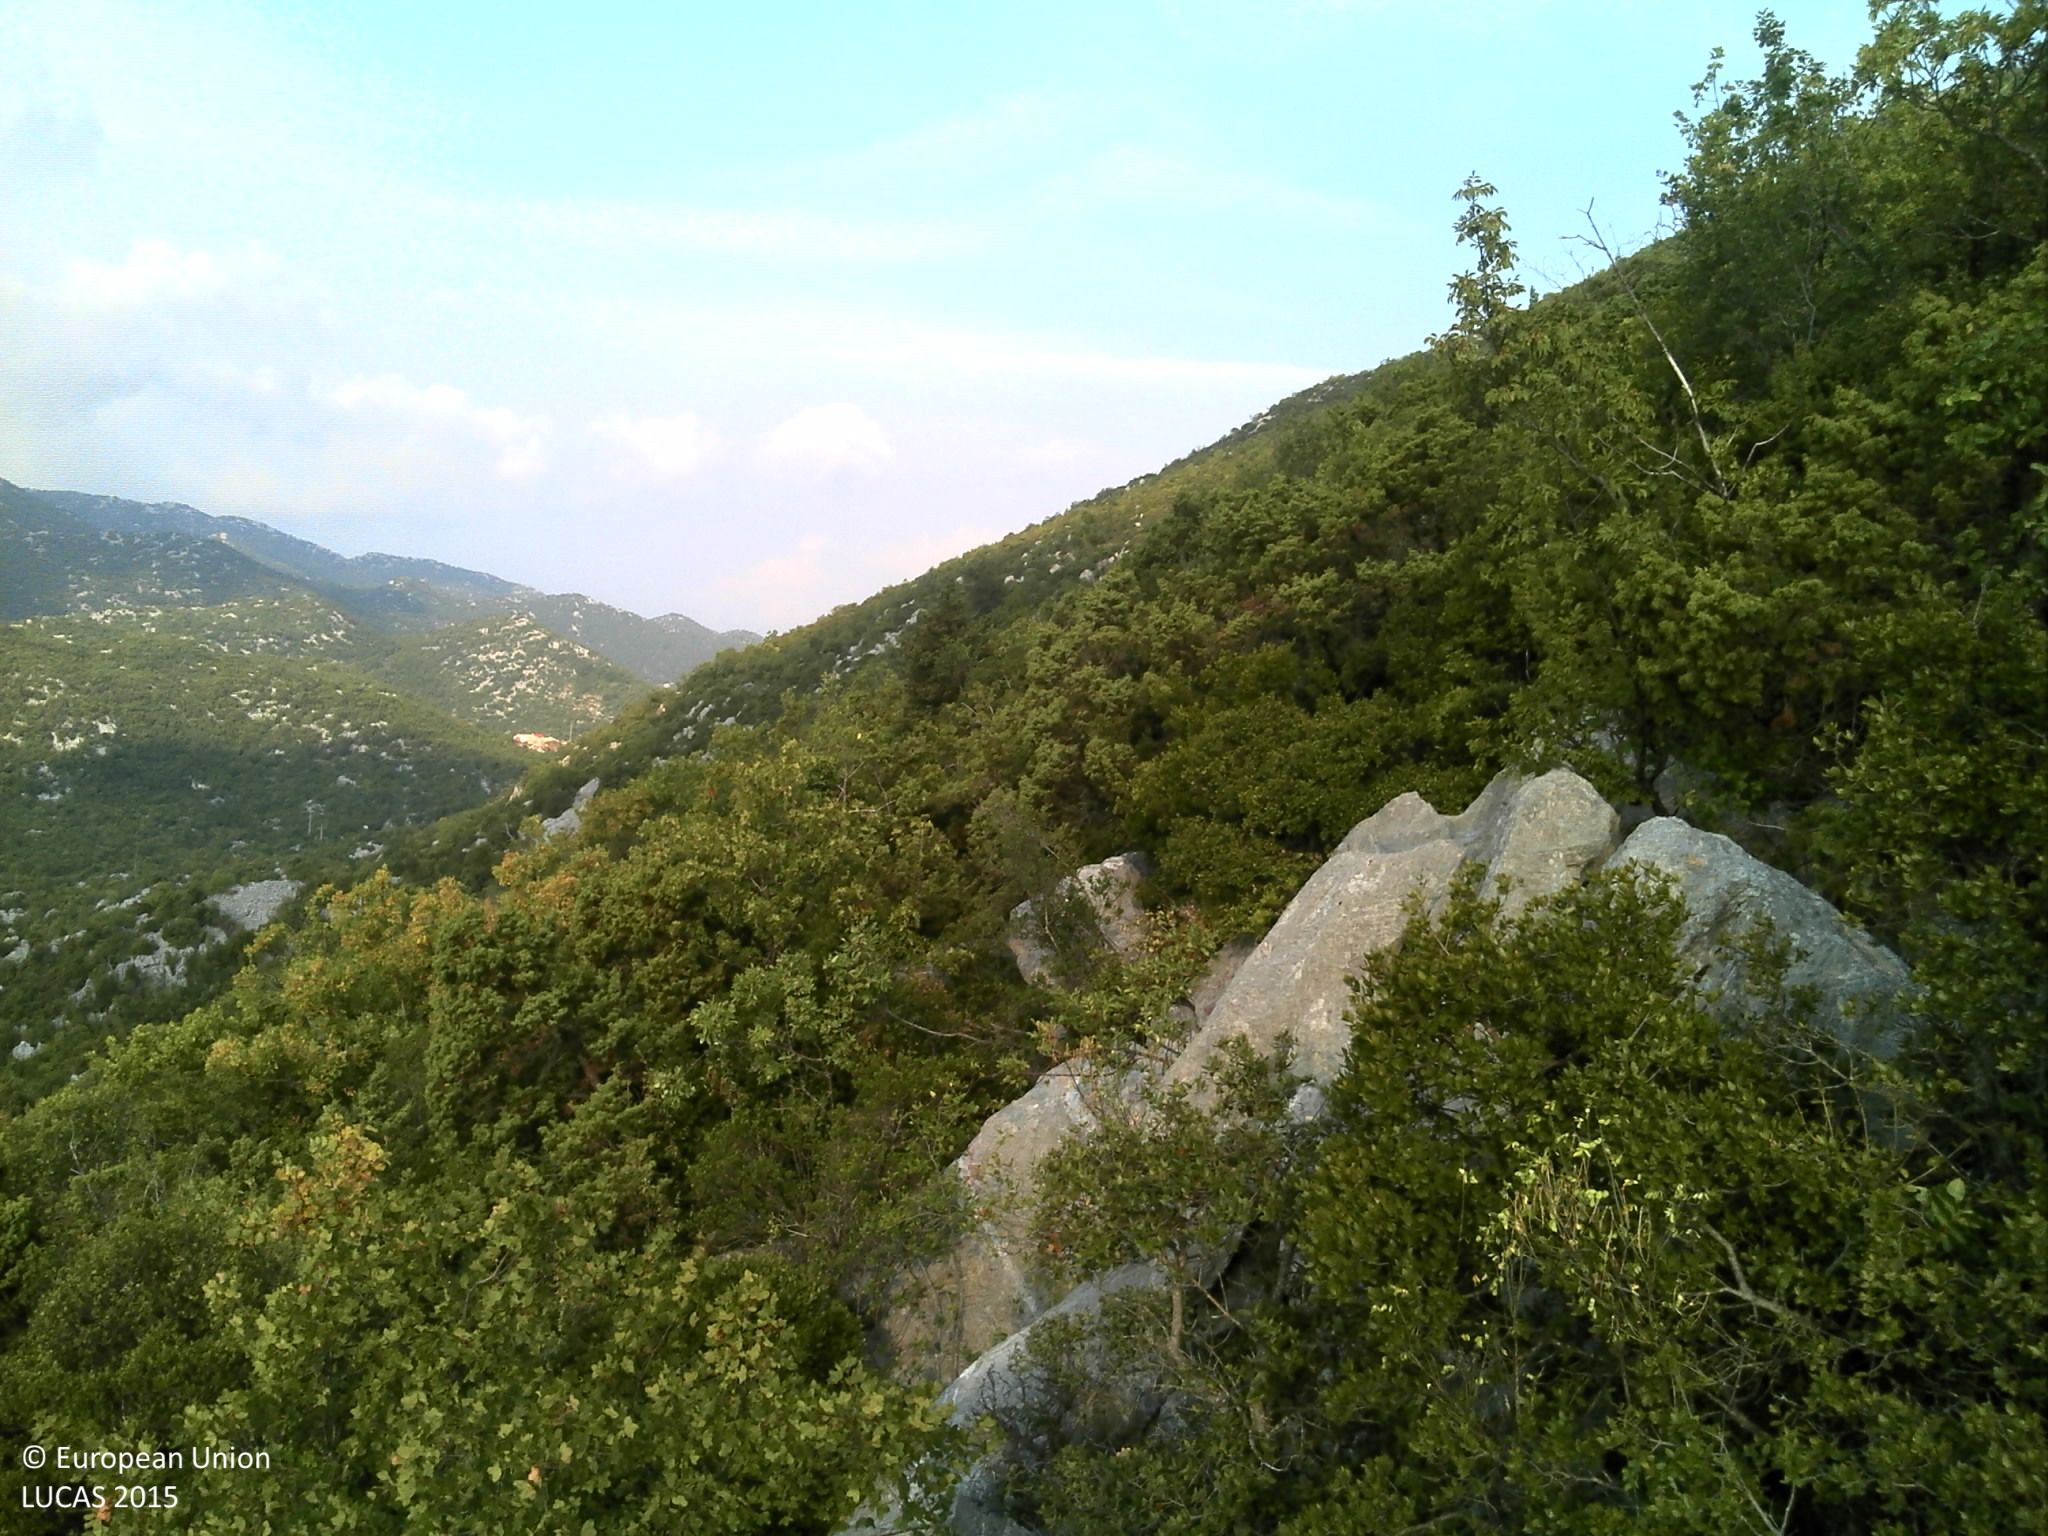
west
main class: Shrubland
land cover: Shrubland with sparse tree cover
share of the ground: > 75 %
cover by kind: shrubs 65 %, unconsolidated bare surface 15 %, consolidated bare surface 10 %, broadleaved forest trees 5 %, herbaceous plants 5 %
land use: Semi-natural and natural areas not in use
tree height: < 5 m
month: August
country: HR
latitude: 43.2118
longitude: 17.2163
